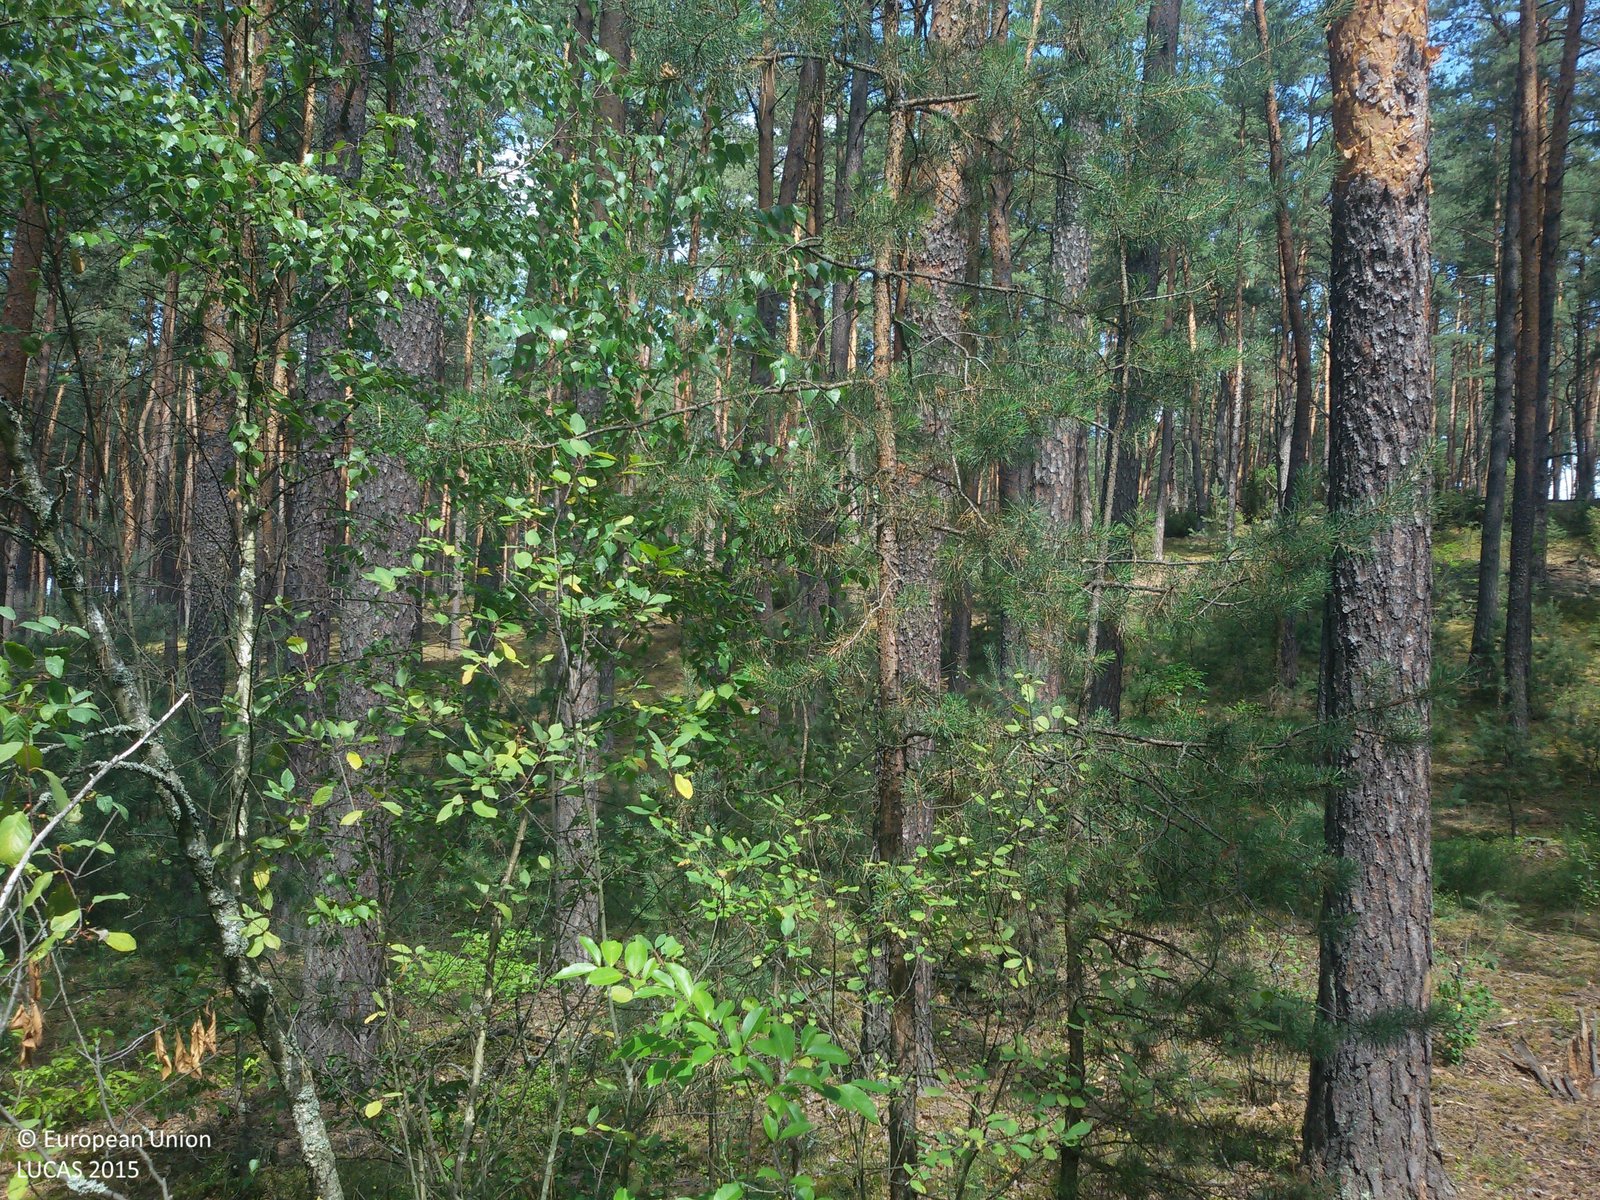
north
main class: Woodland
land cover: Pine dominated mixed woodland
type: hemiboreal forest and nemoral coniferous forest and mixed broadleaved-coniferous forest
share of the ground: 50 - 75 %
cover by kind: coniferous forest trees 35 %, broadleaved forest trees 30 %, herbaceous plants 30 %, shrubs 5 %
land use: Forestry
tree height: > 5 m
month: July
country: PL
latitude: 51.4753
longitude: 23.4885
